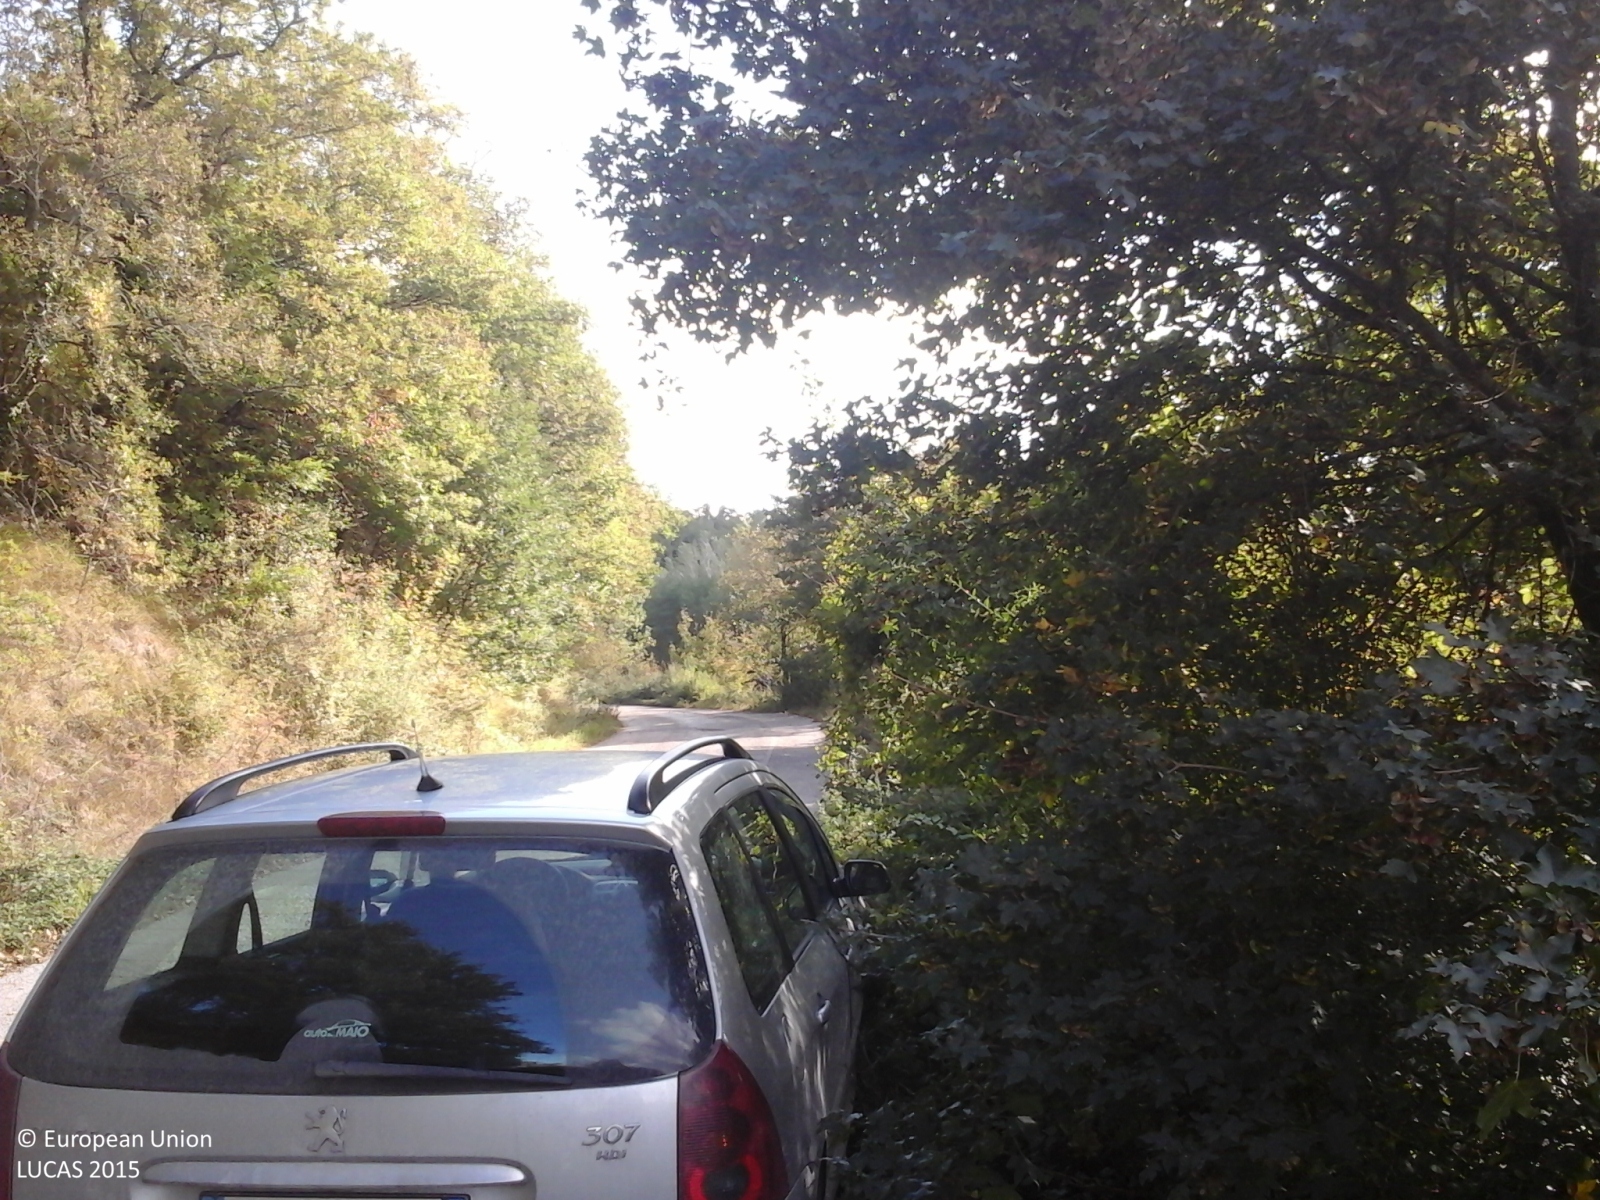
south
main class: Woodland
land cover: Broadleaved woodland
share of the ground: > 75 %
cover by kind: broadleaved forest trees 95 %, herbaceous plants 5 %
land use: Semi-natural and natural areas not in use
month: October
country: IT
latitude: 43.2623
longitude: 12.1989
